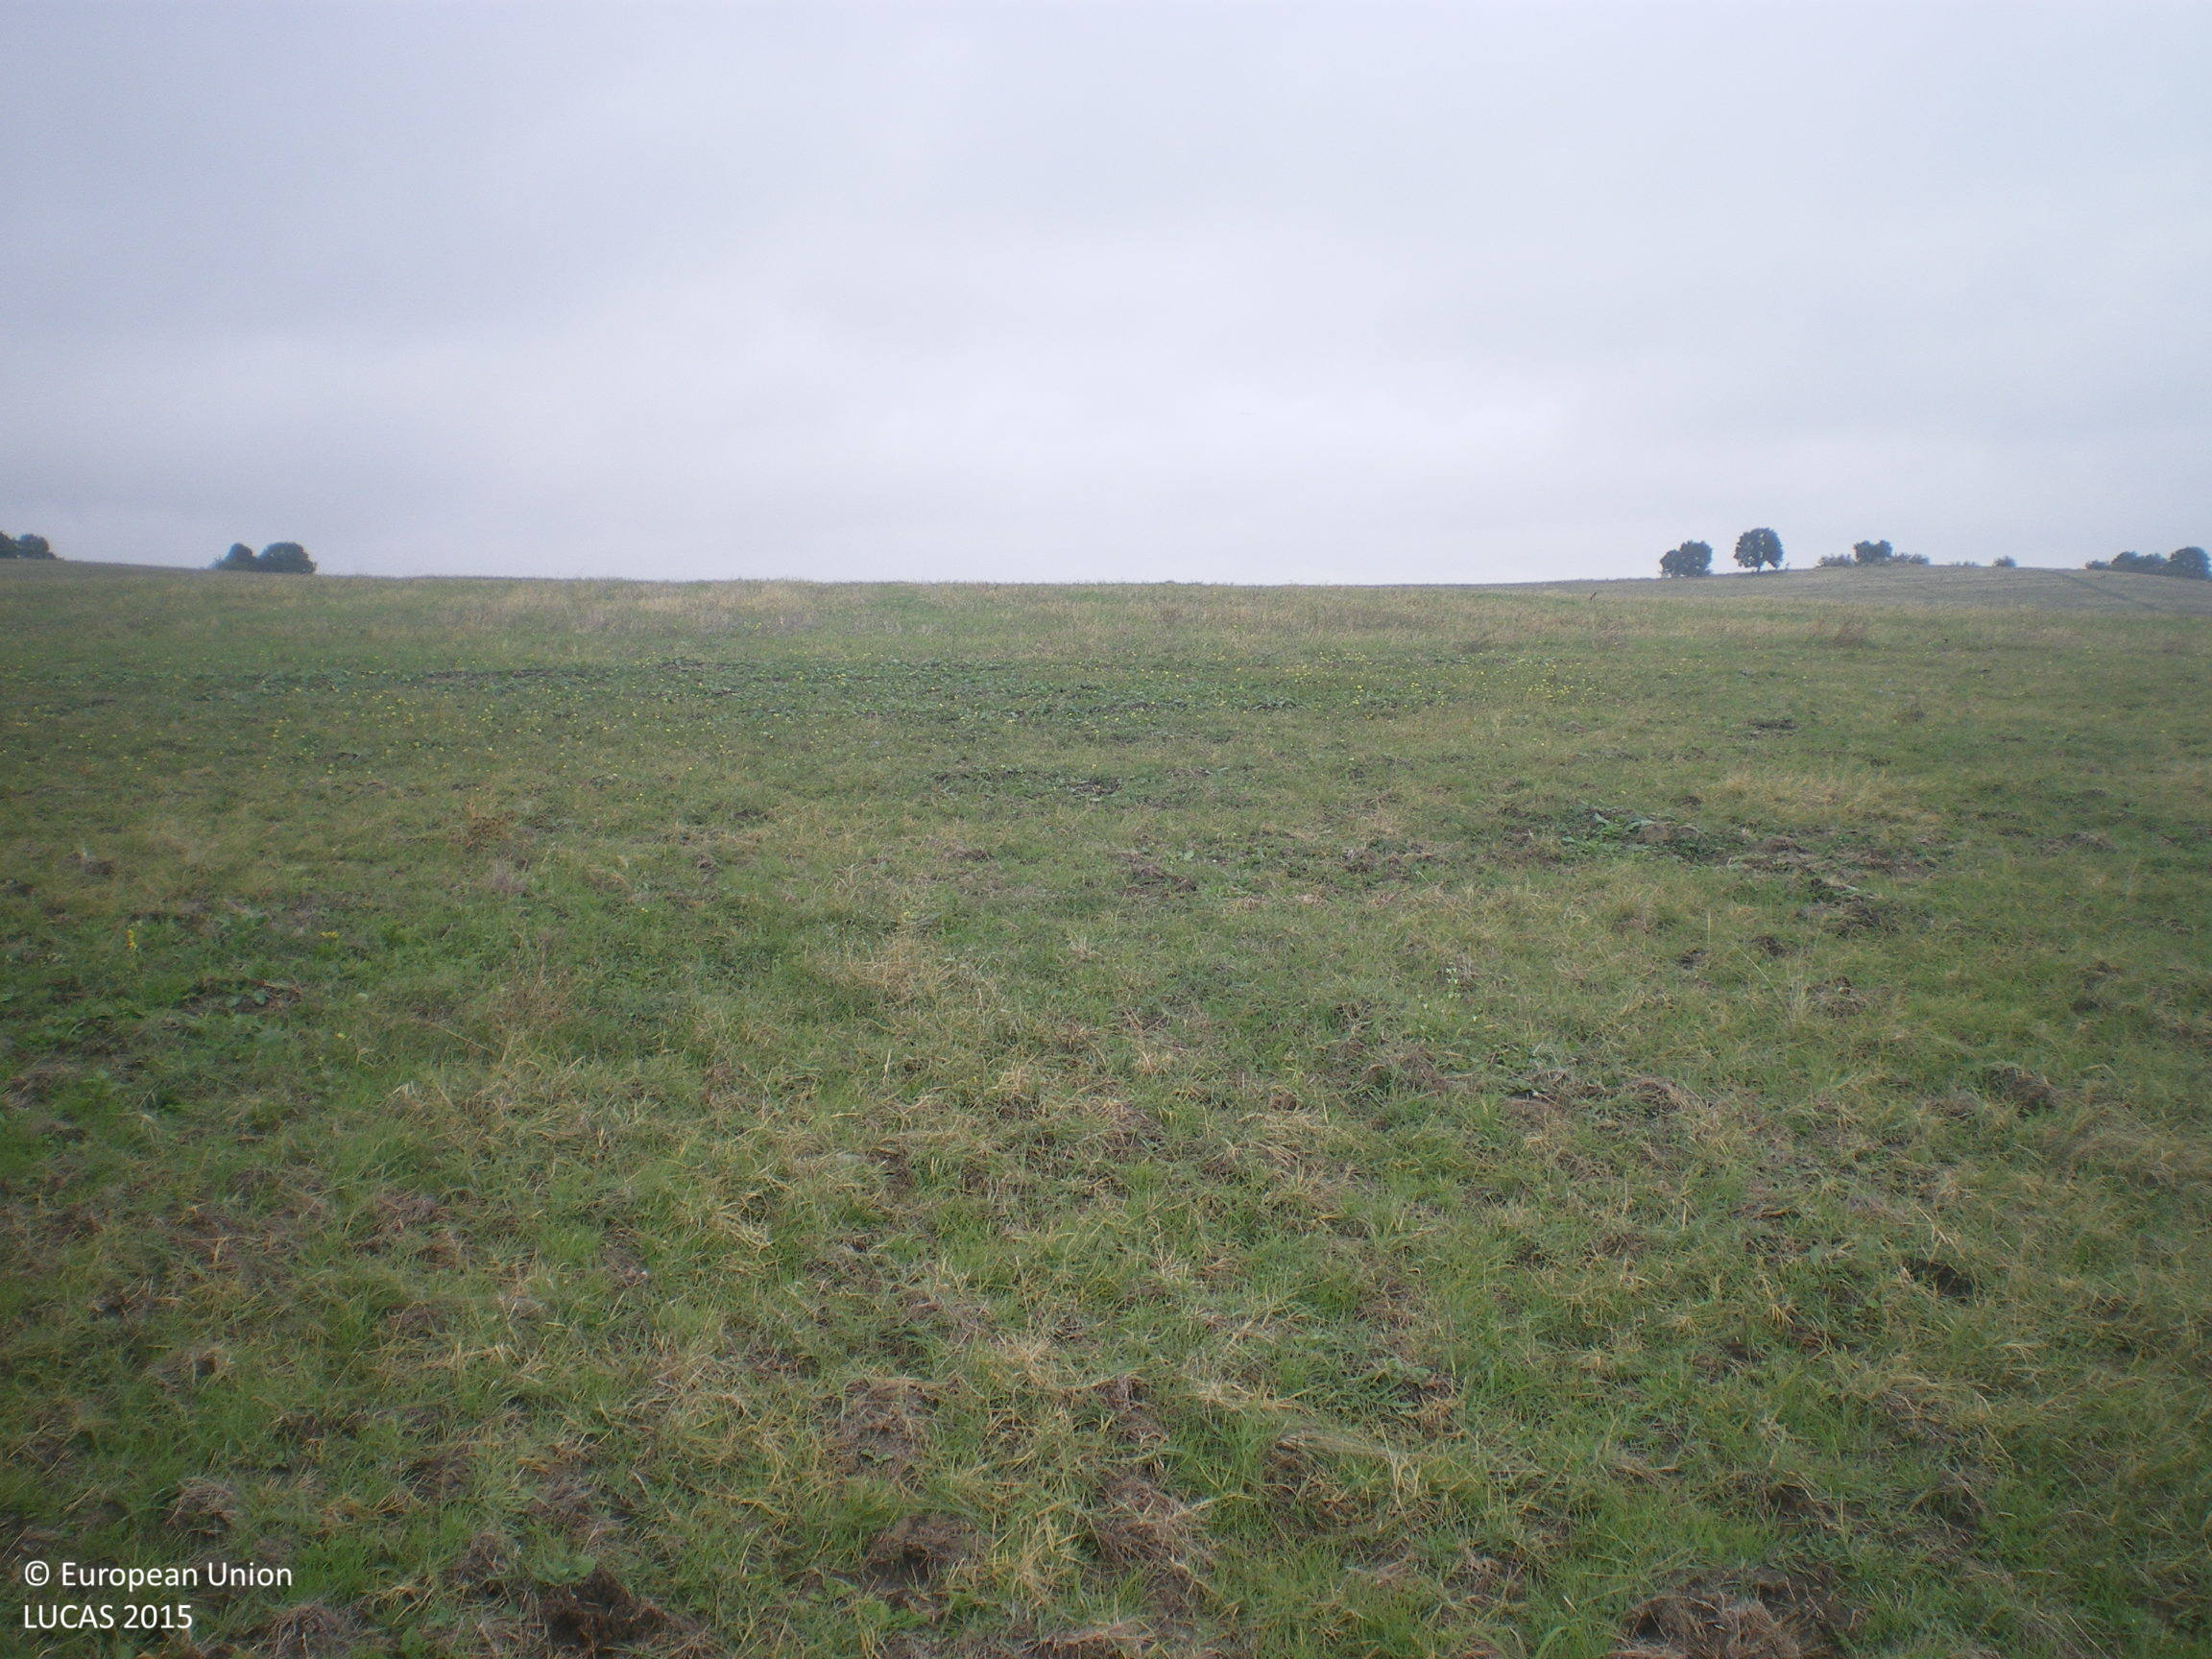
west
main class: Cropland
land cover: Common wheat
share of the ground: < 10 %
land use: Agriculture (excluding fallow land and kitchen gardens)
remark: Harvested field
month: October
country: BG
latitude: 41.8398
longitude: 26.1772
